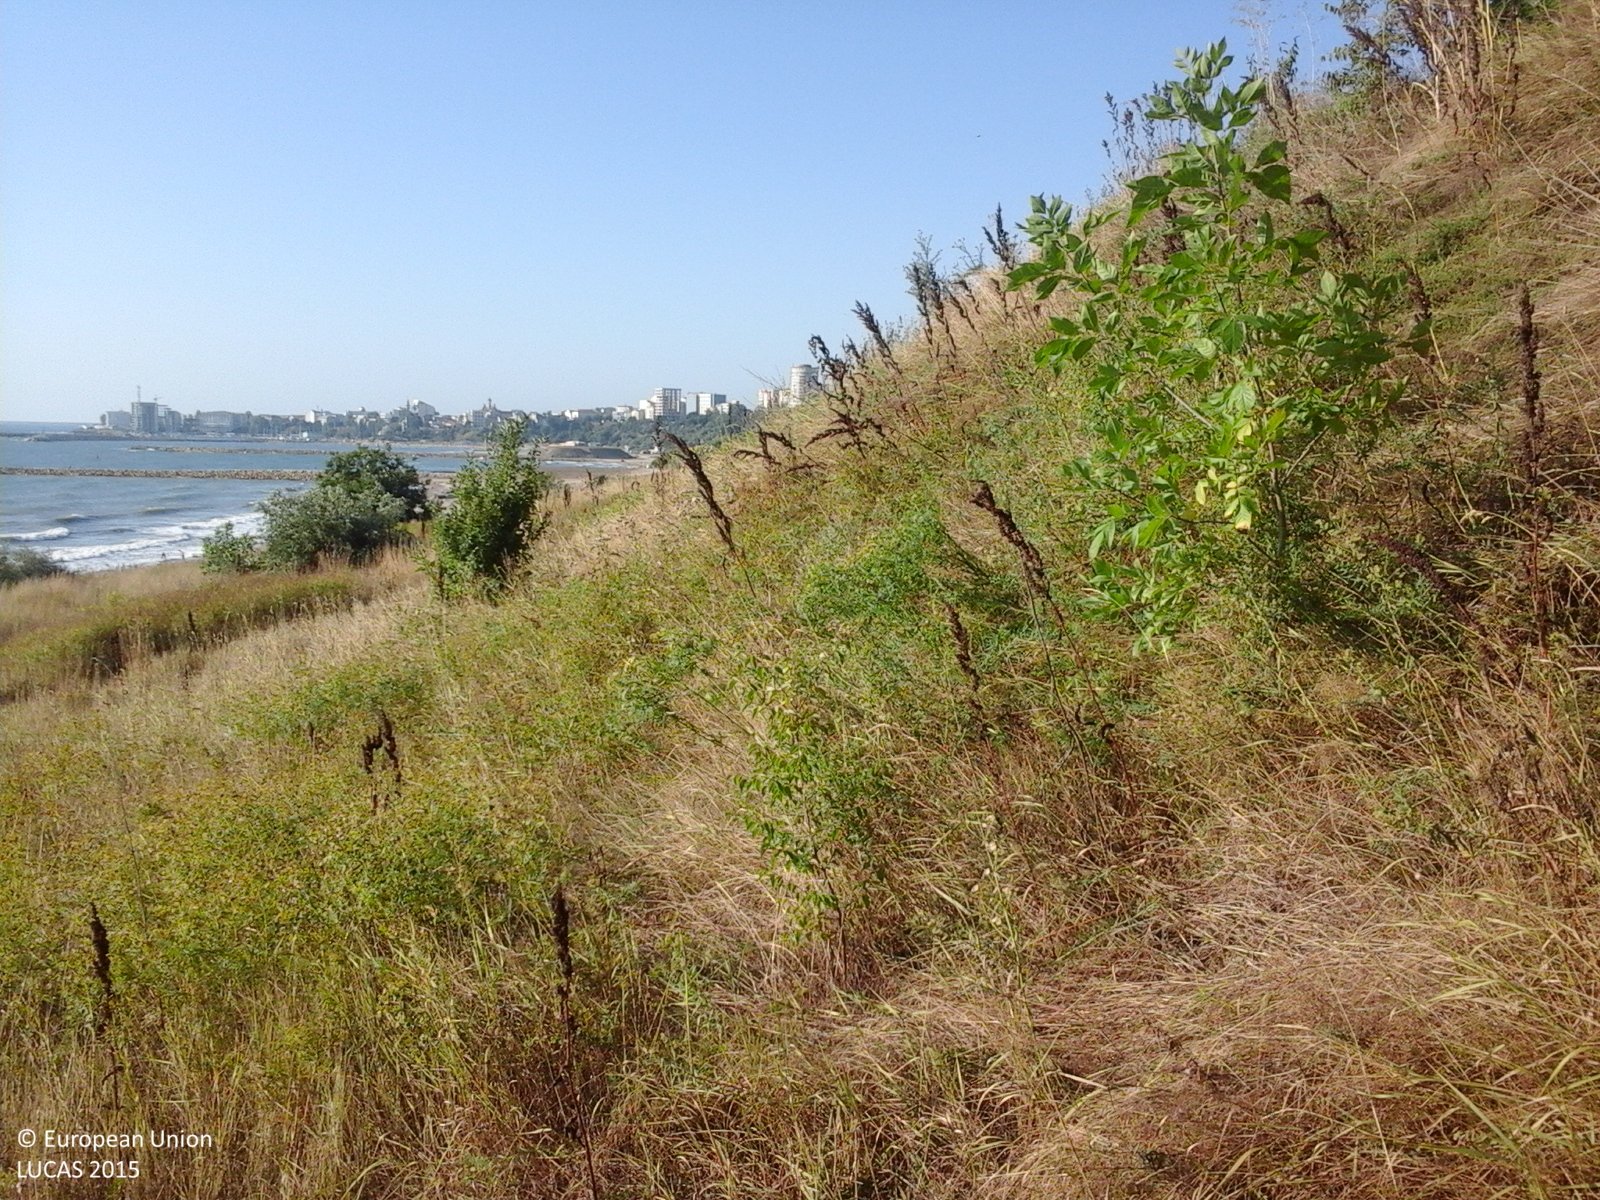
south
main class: Grassland
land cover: Spontaneously vegetated surfaces
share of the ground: > 75 %
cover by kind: herbaceous plants 100 %
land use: Semi-natural and natural areas not in use
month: August
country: RO
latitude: 44.1923
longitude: 28.6543
